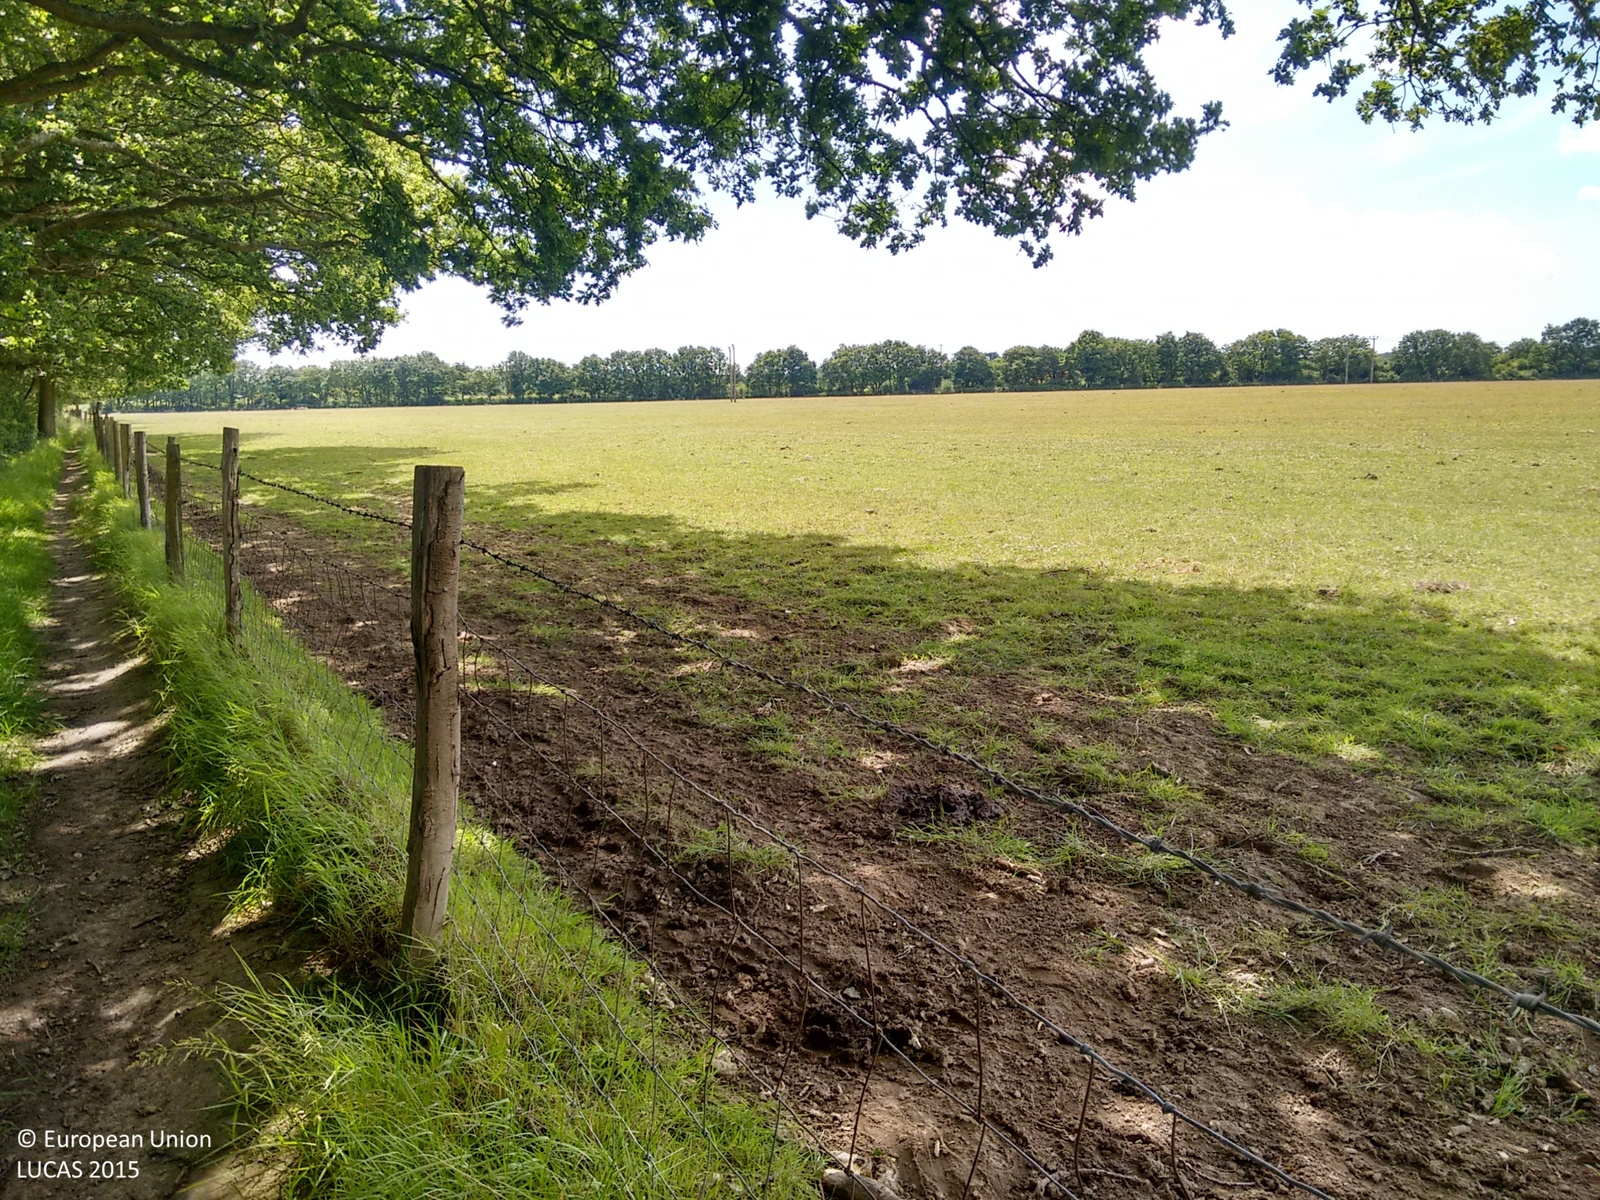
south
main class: Grassland
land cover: Grassland without tree/shrub cover
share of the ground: > 75 %
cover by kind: herbaceous plants 100 %
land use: Agriculture (excluding fallow land and kitchen gardens)
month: June
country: GB
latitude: 51.1625
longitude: -0.1444
